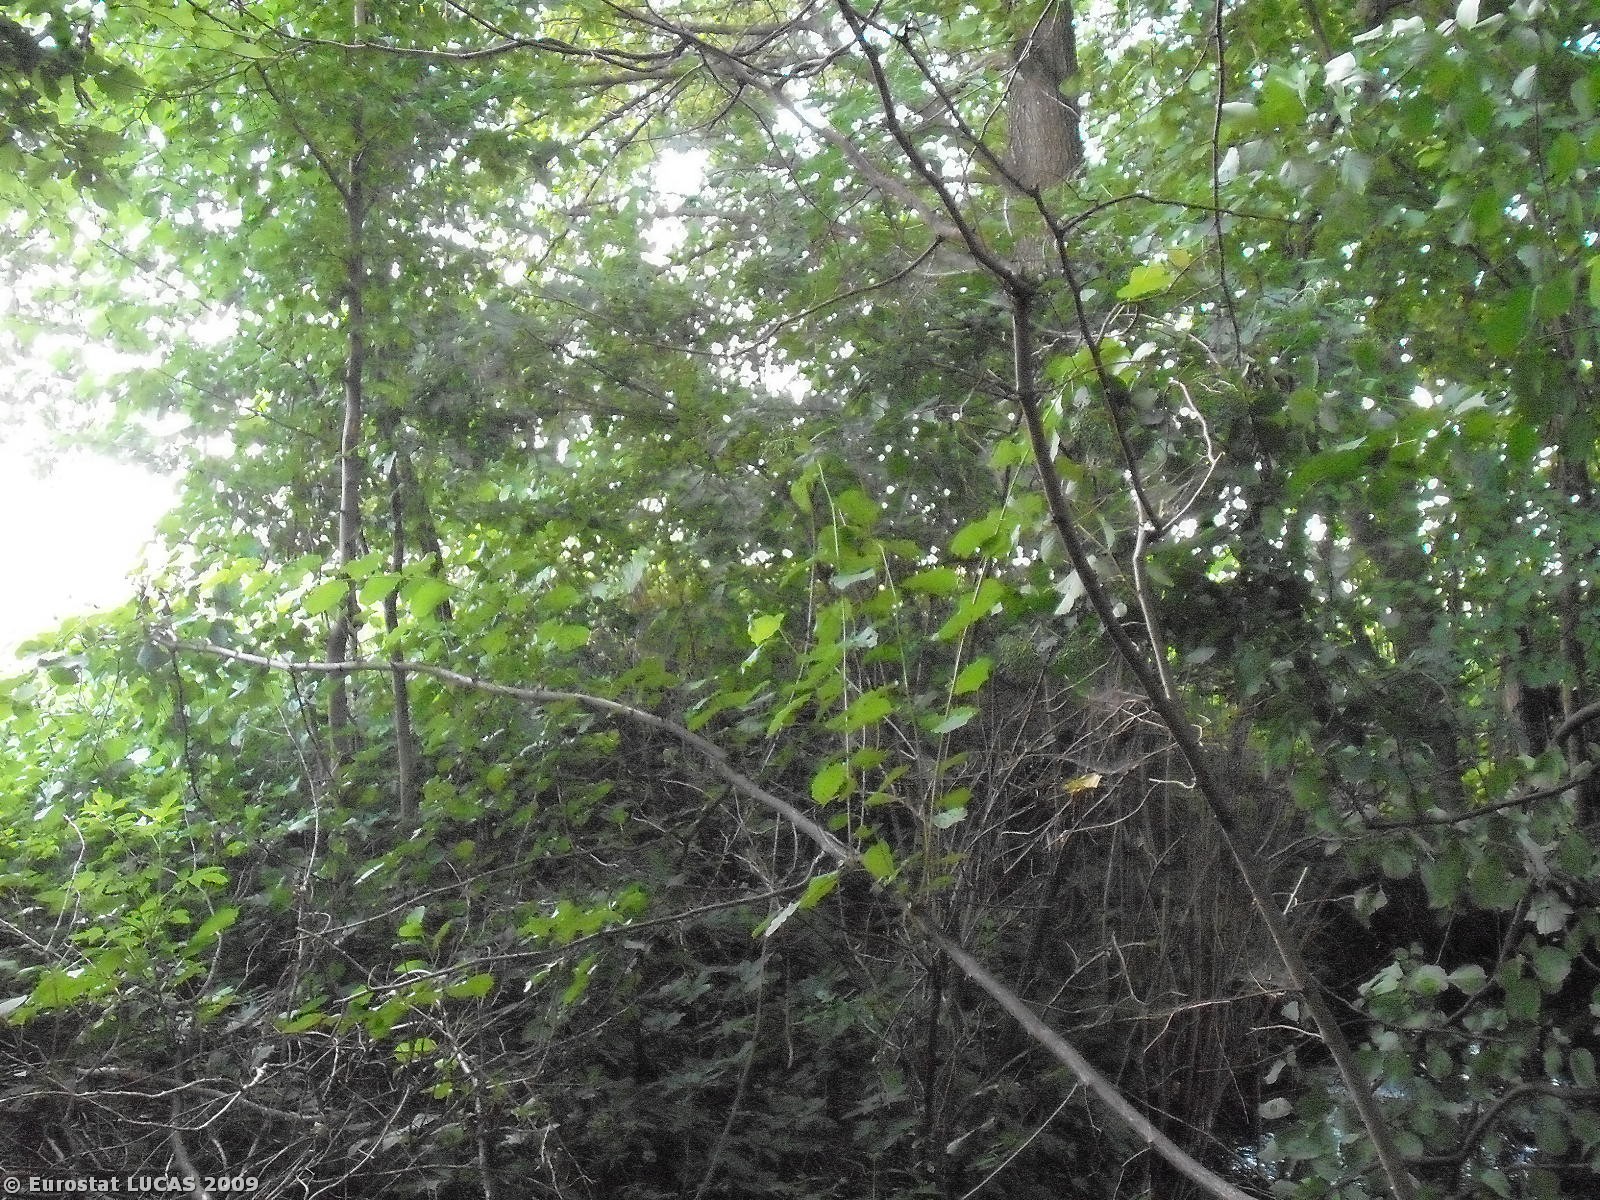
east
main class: Woodland
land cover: Broadleaved woodland
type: floodplain forest
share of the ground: > 75 %
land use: Unused
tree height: > 5 m
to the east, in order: Broadleaved woodland; Rivers and streams; Broadleaved woodland; Oats; Spontaneously vegetated surfaces; Paved roads, cycling and walking lanes; Grass margins; Electric lines; Rye; Electric lines; Rye
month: July
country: PL
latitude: 51.2590
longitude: 21.4426
